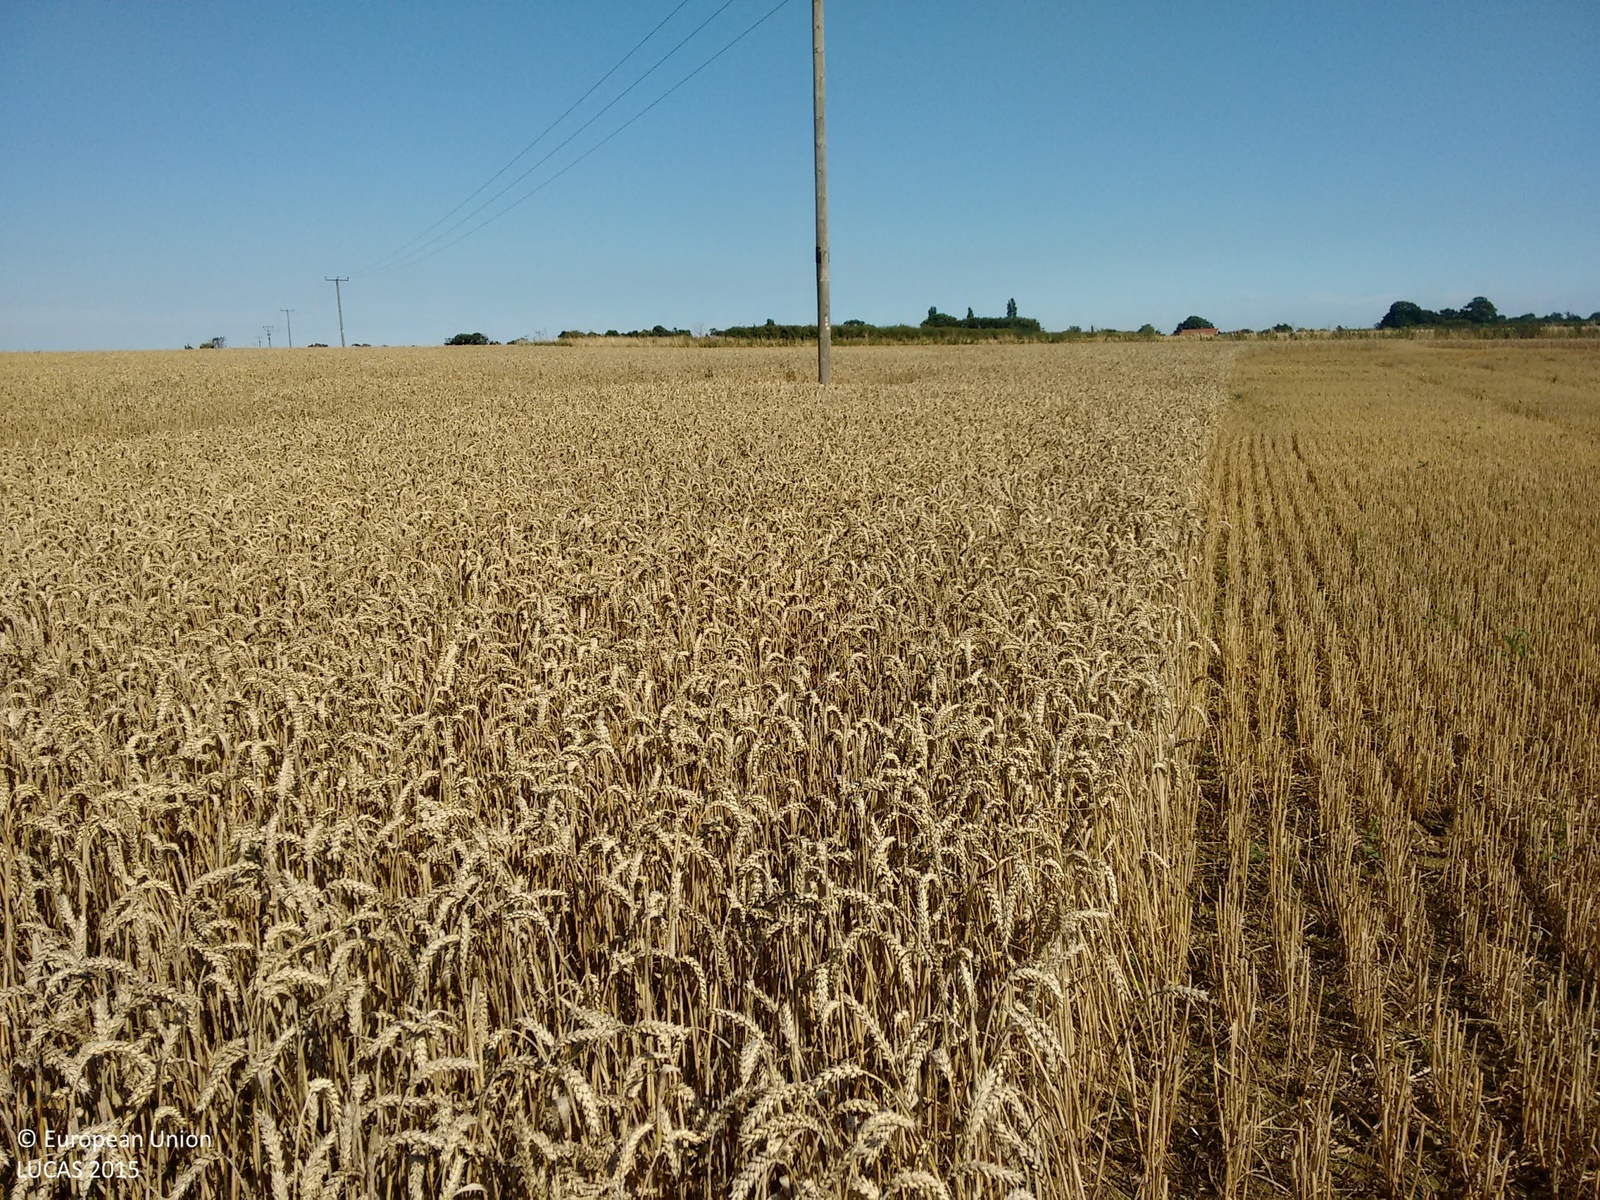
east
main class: Cropland
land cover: Common wheat
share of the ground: > 75 %
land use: Agriculture (excluding fallow land and kitchen gardens)
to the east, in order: Common wheat; Electric lines; Common wheat; Grass margins; Common wheat; Grass margins; Common wheat
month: August
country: GB
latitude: 52.1397
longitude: 1.4326
